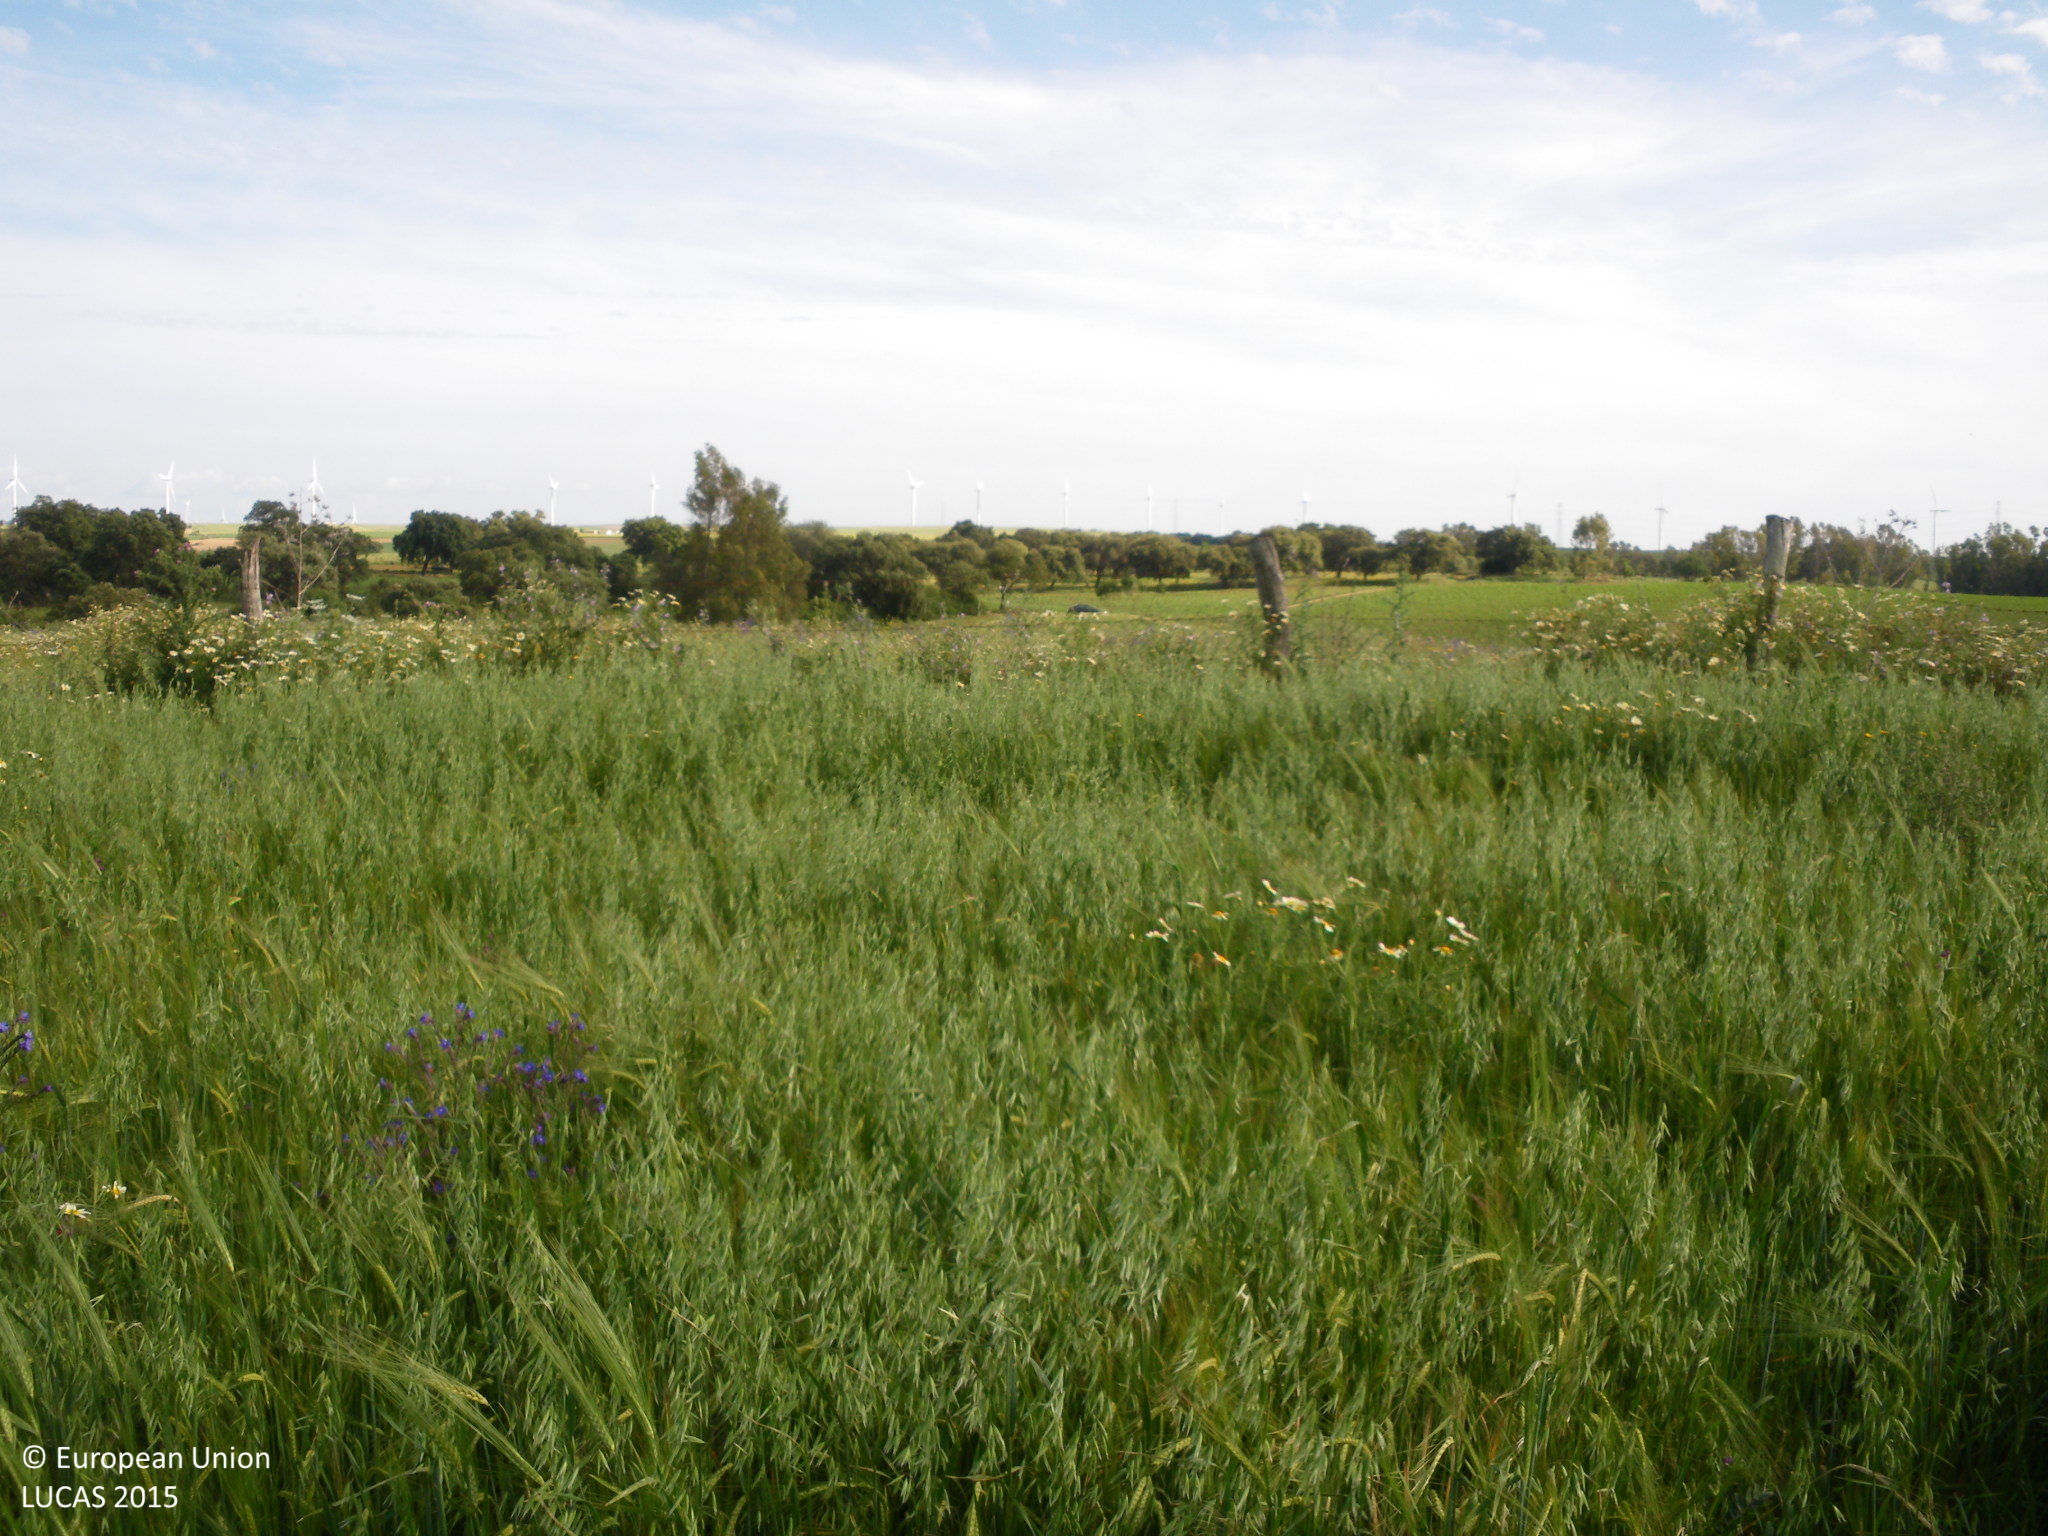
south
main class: Cropland
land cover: Mixed cereals for fodder
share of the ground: > 75 %
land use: Agriculture (excluding fallow land and kitchen gardens)
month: April
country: ES
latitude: 36.6046
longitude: -5.8928
